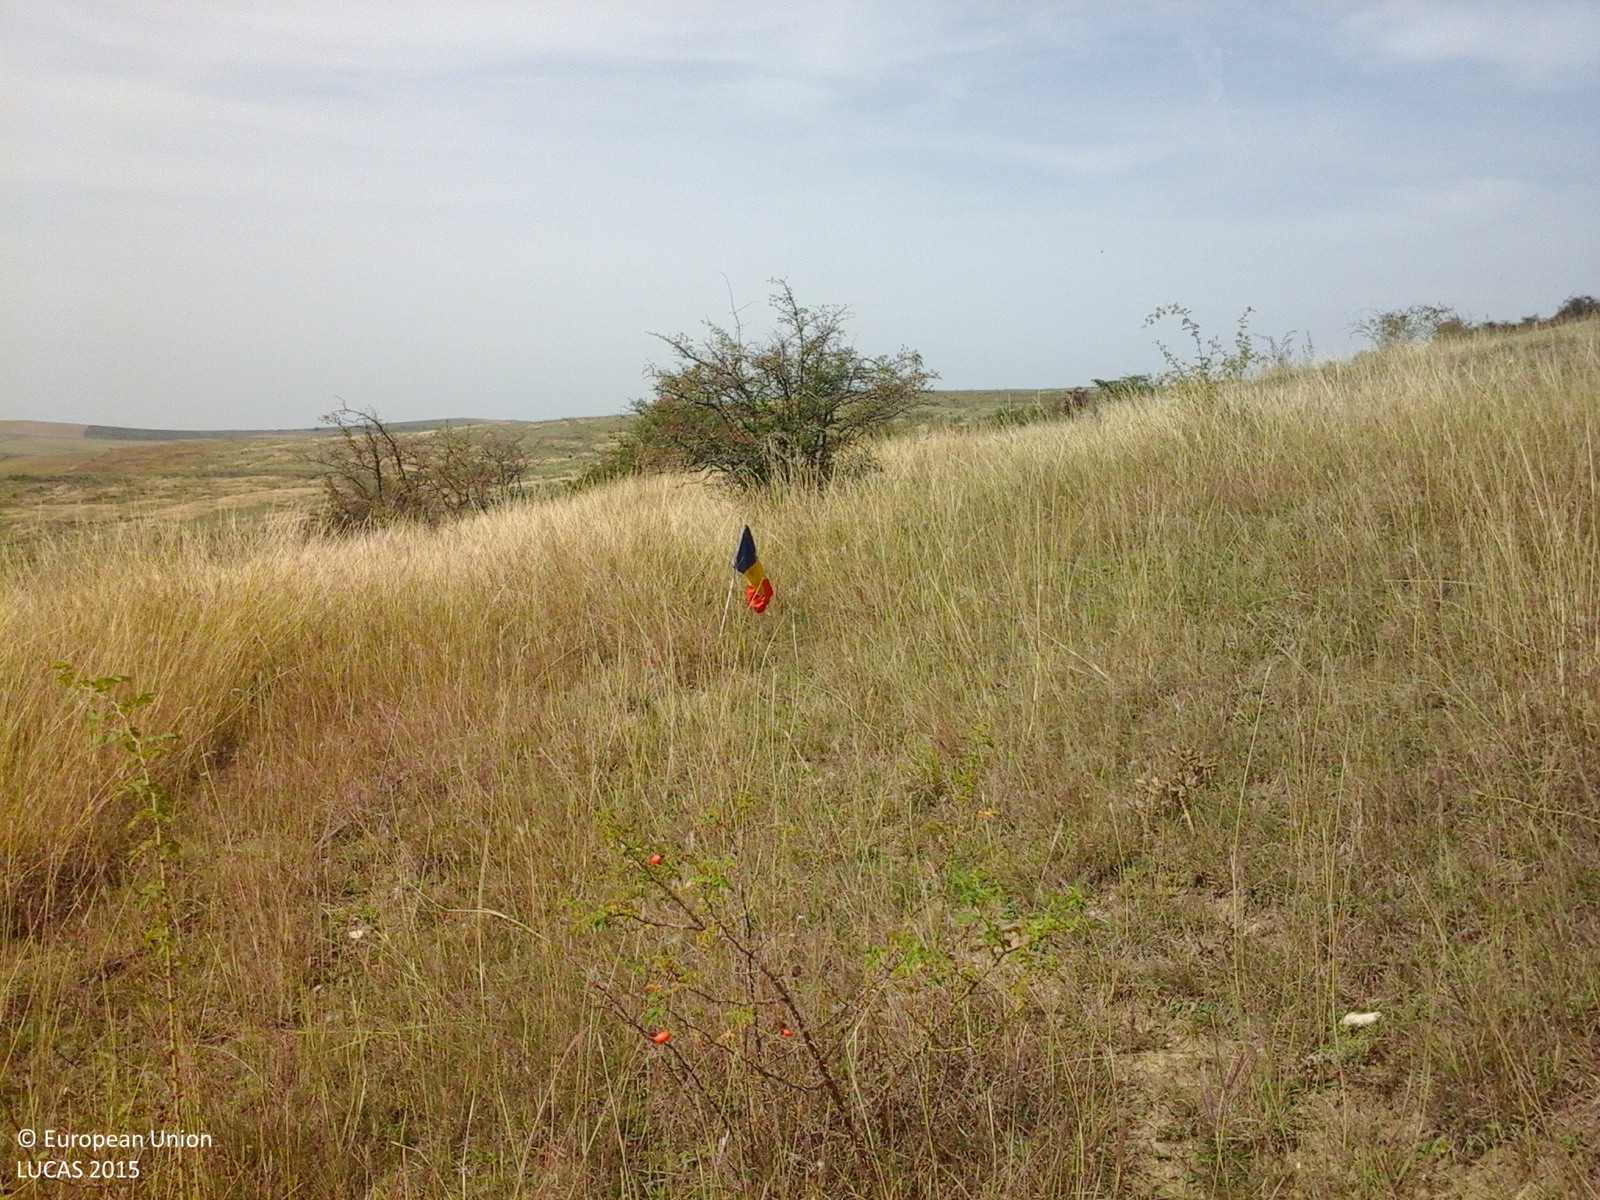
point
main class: Grassland
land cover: Grassland with sparse tree/shrub cover
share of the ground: > 75 %
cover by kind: herbaceous plants 85 %, shrubs 10 %, broadleaved forest trees 5 %
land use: Agriculture (excluding fallow land and kitchen gardens)
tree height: < 5 m
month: September
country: RO
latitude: 46.9084
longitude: 23.6882
